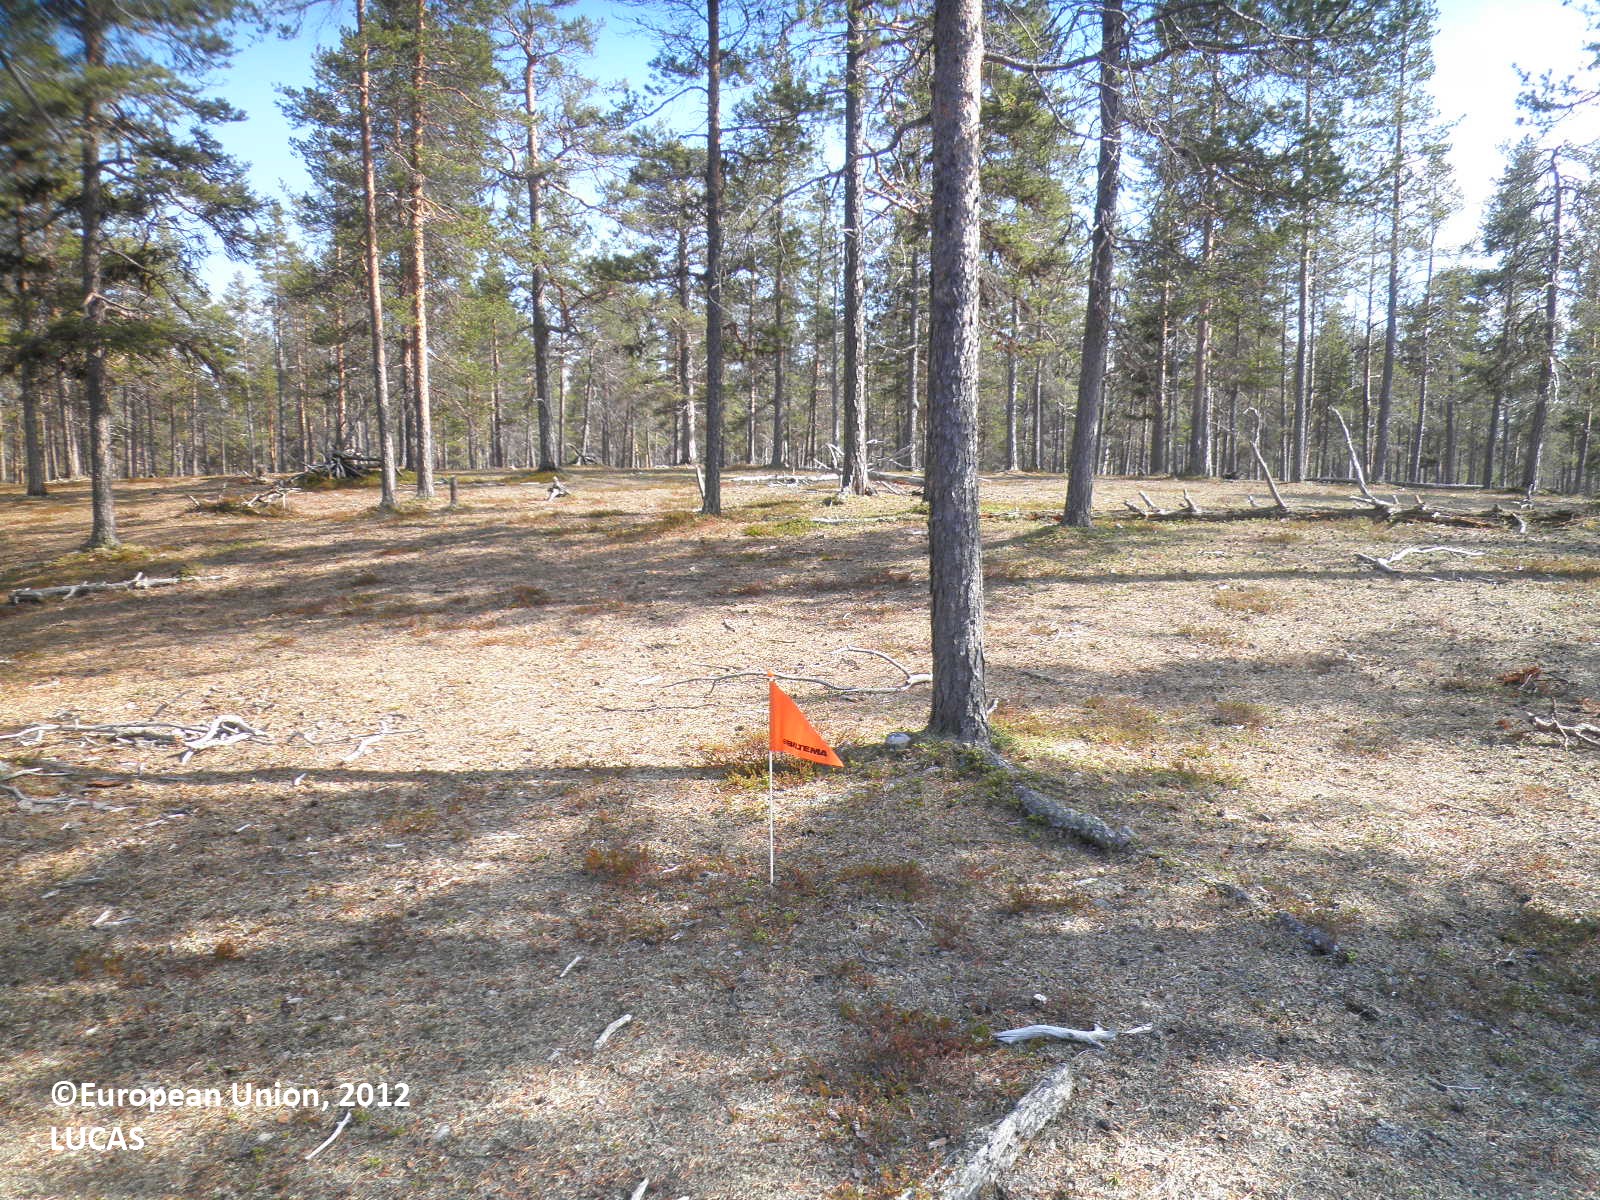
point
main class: Woodland
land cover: Pine dominated coniferous woodland
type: boreal forest
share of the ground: 10 - 25 %
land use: Forestry
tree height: > 5 m
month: June
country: FI
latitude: 68.9009
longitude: 26.0936
